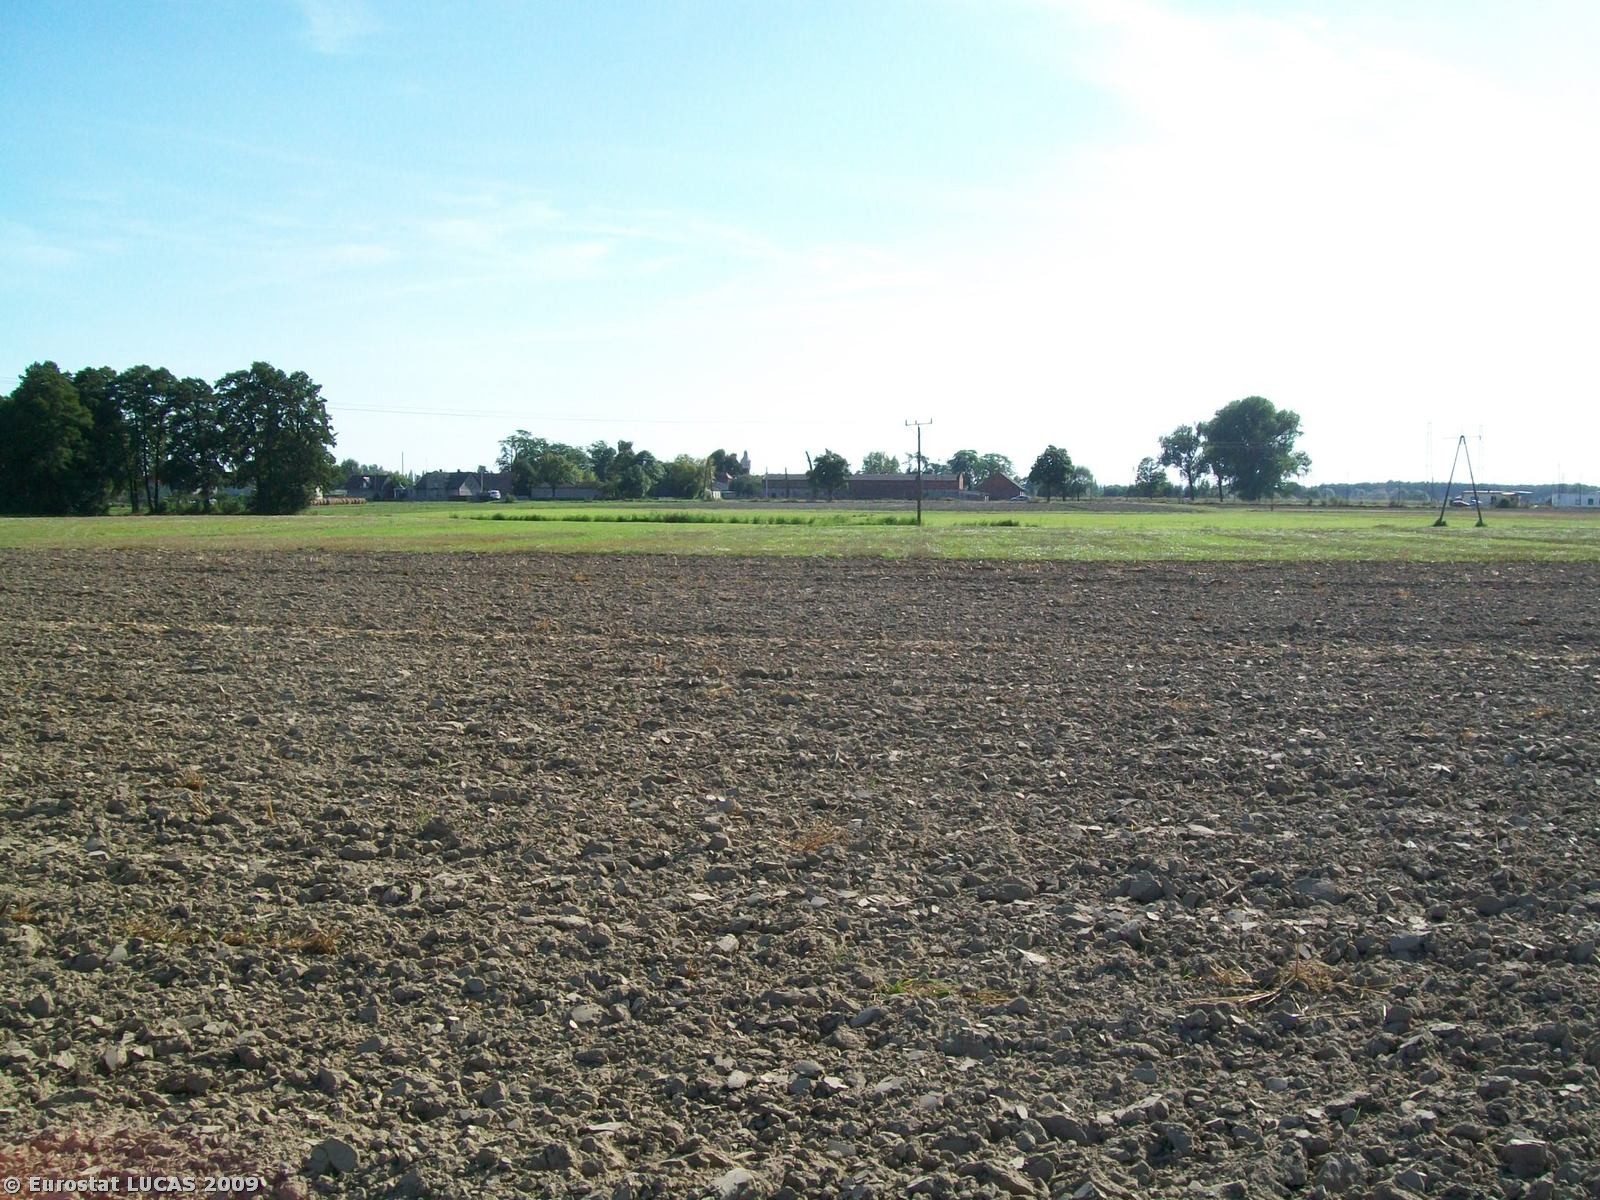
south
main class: Cropland
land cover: Oats
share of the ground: < 10 %
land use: Agriculture (excluding fallow land and kitchen gardens)
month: September
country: PL
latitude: 51.2959
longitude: 17.9752
